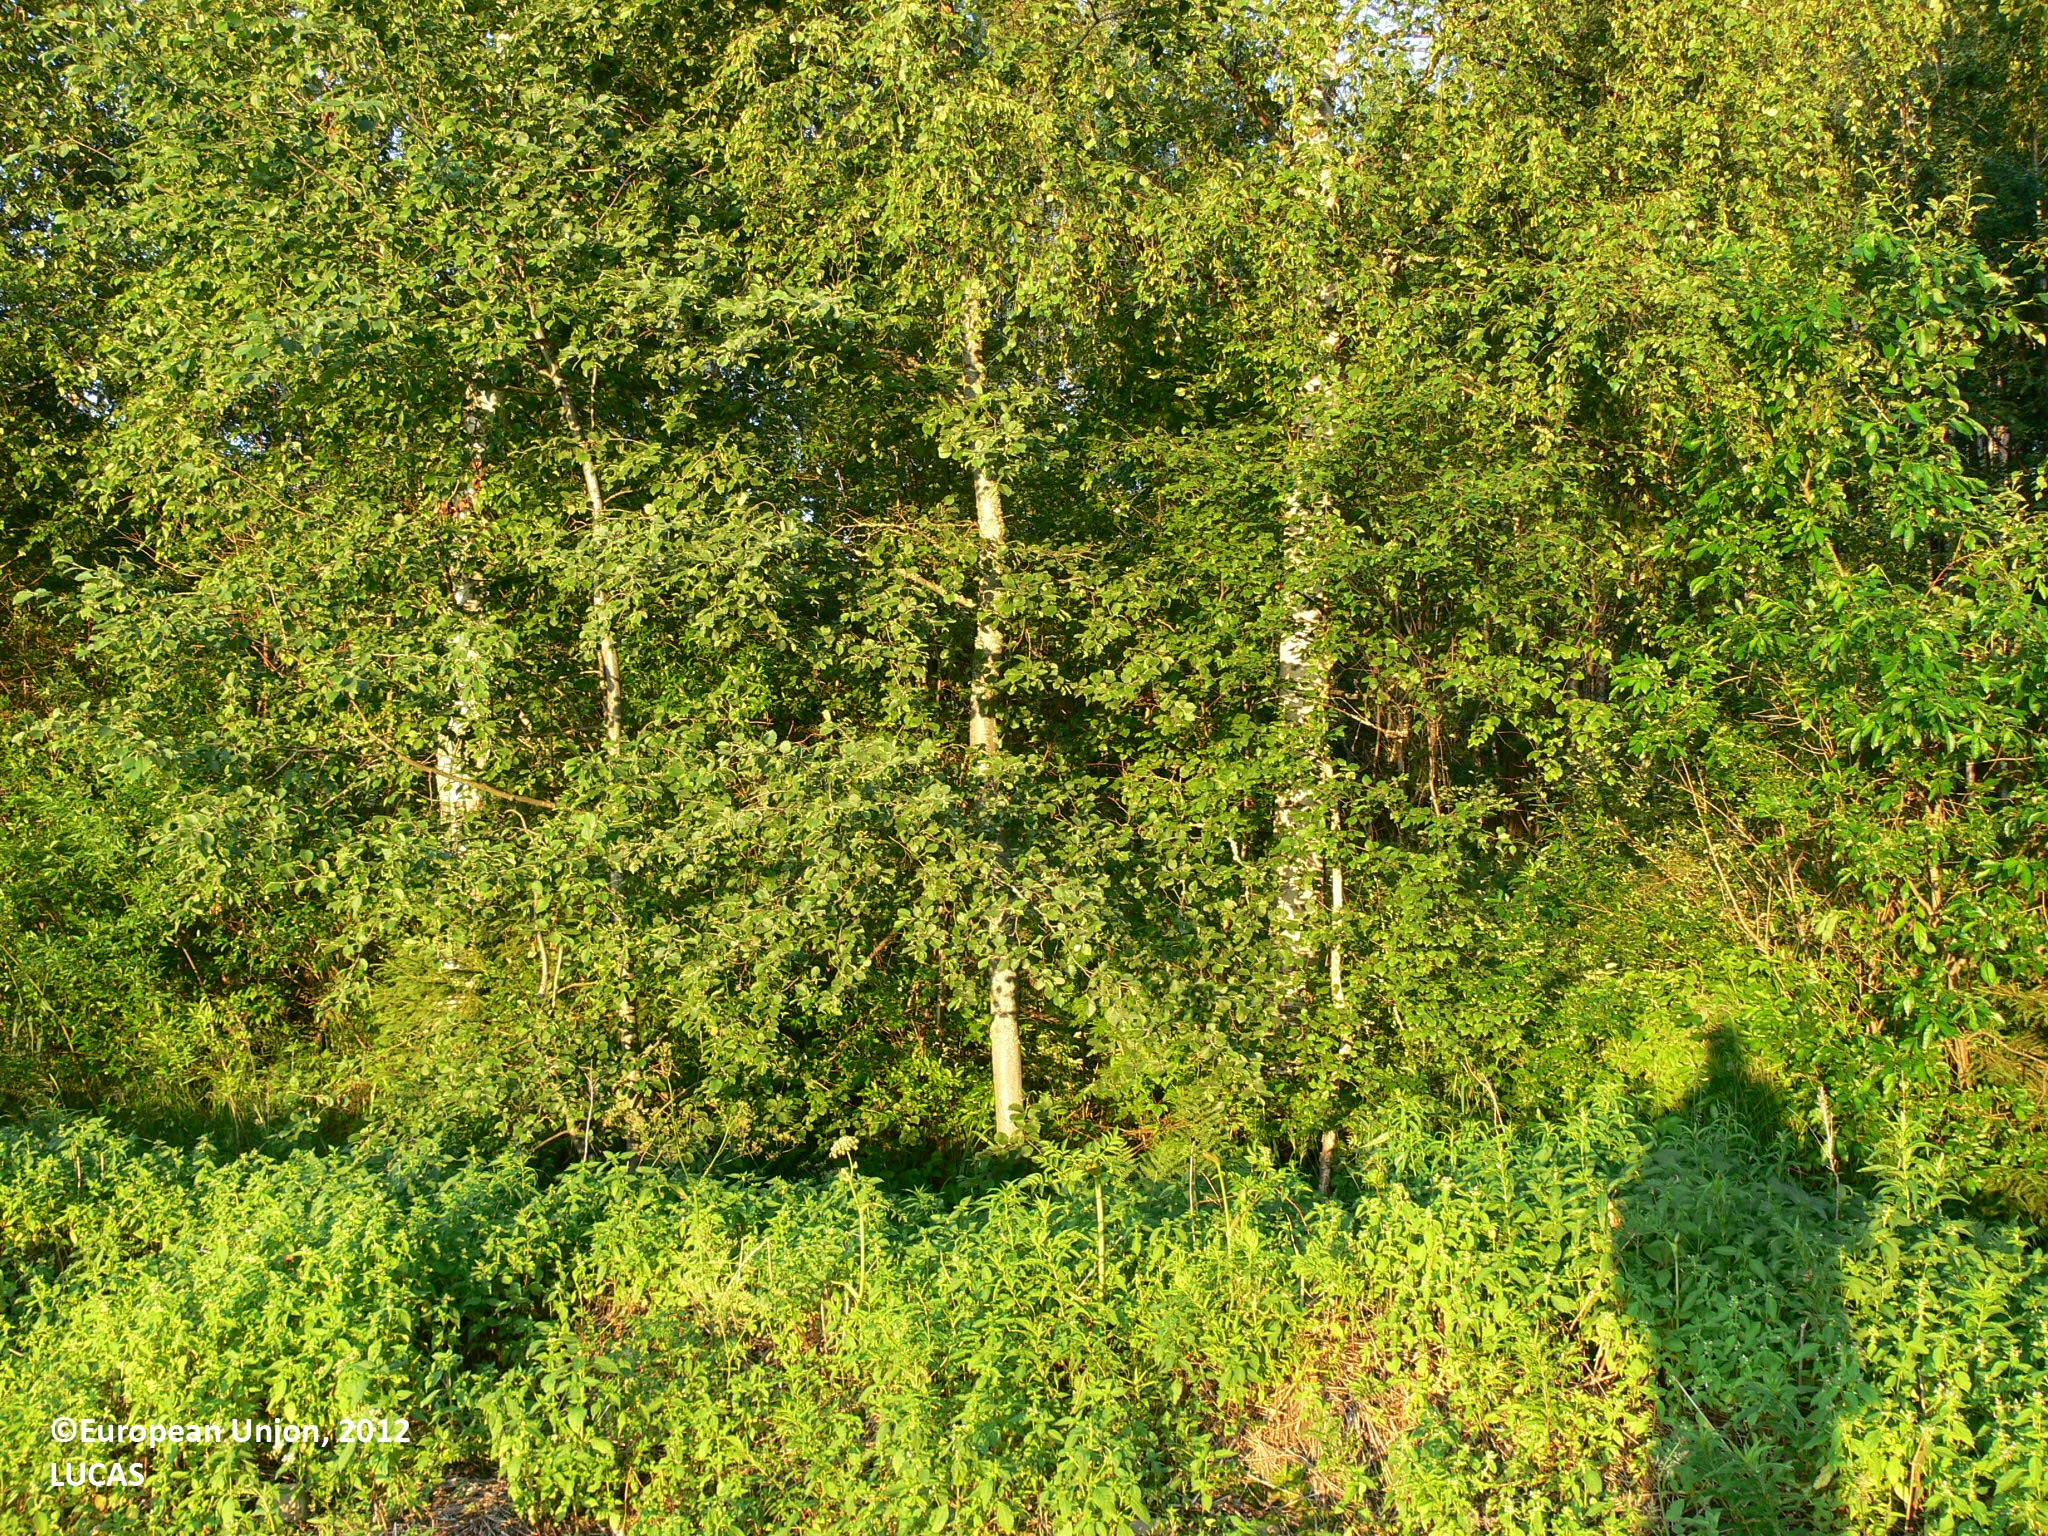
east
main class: Cropland
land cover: Barley
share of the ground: > 75 %
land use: Agriculture (excluding fallow land and kitchen gardens)
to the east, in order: Barley; Ditches and canals; Arable land (only in case pi); Ditches and canals; Arable land (only in case pi)
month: July
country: FI
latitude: 62.2902
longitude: 29.6207
